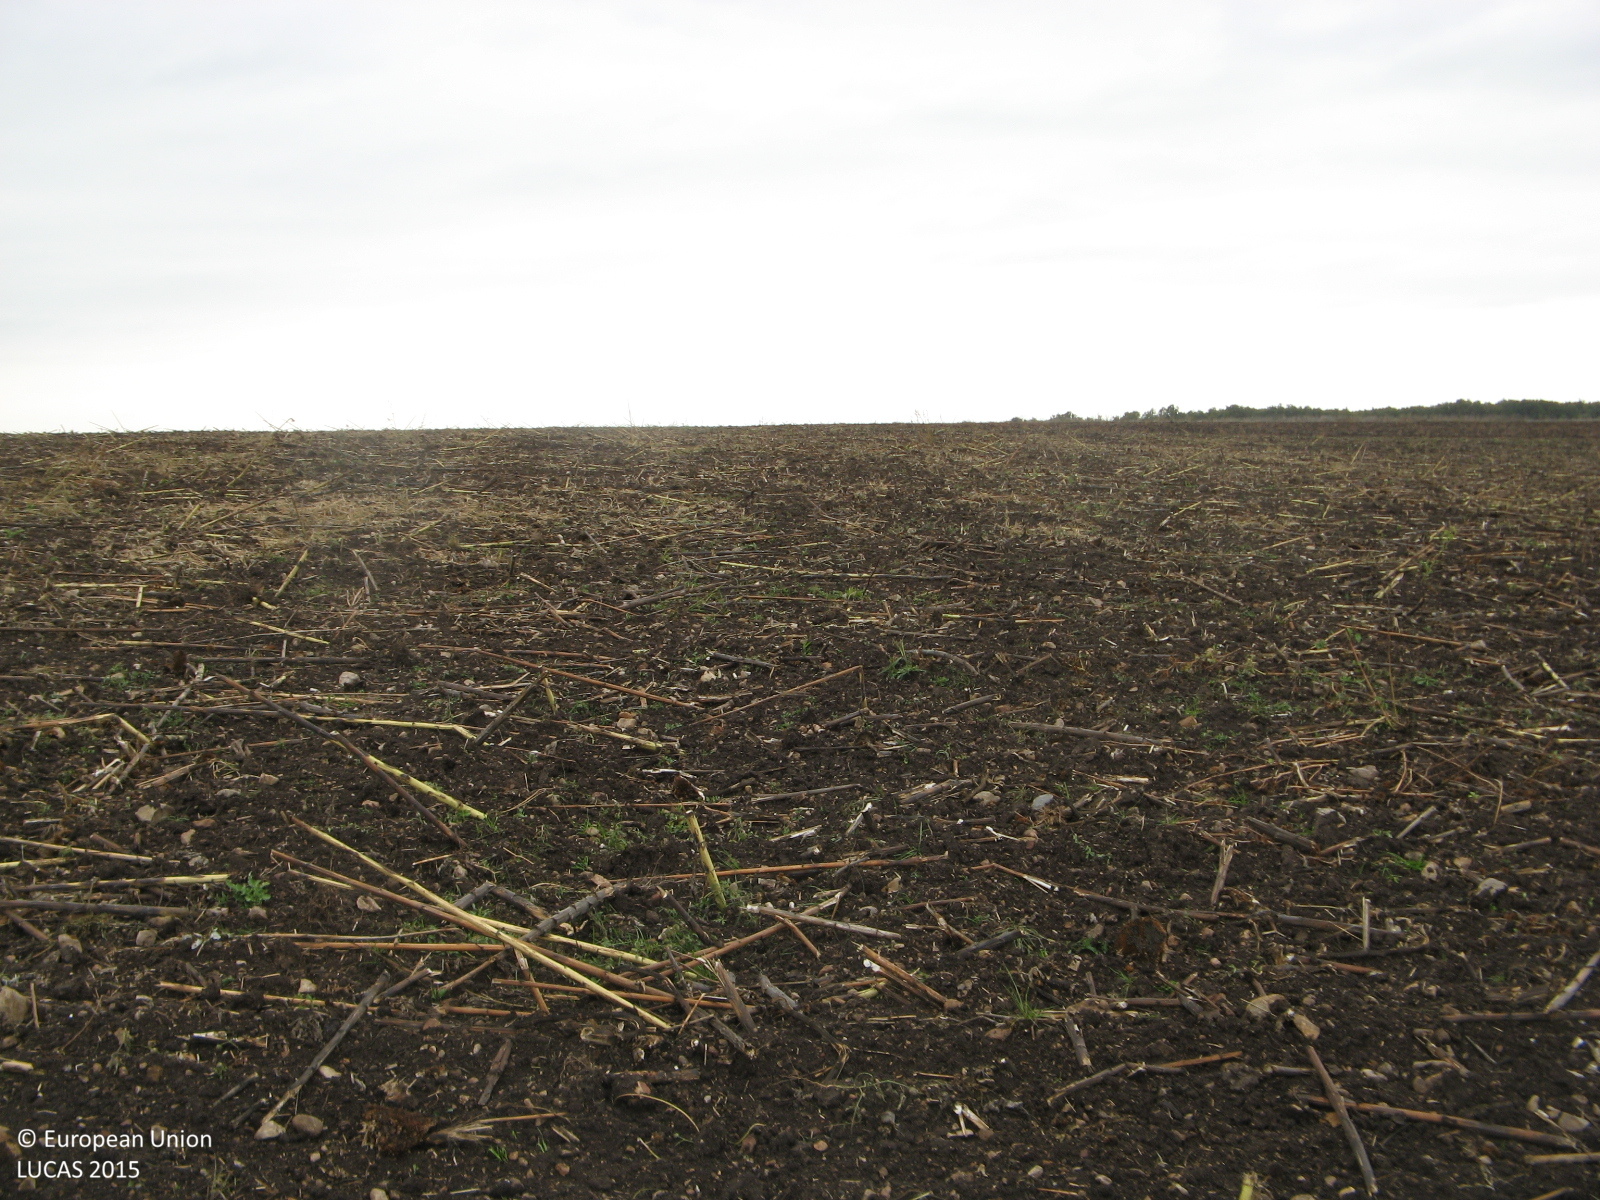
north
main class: Cropland
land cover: Sunflower
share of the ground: < 10 %
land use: Agriculture (excluding fallow land and kitchen gardens)
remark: Harvested field
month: October
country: BG
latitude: 41.9853
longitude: 25.3782
